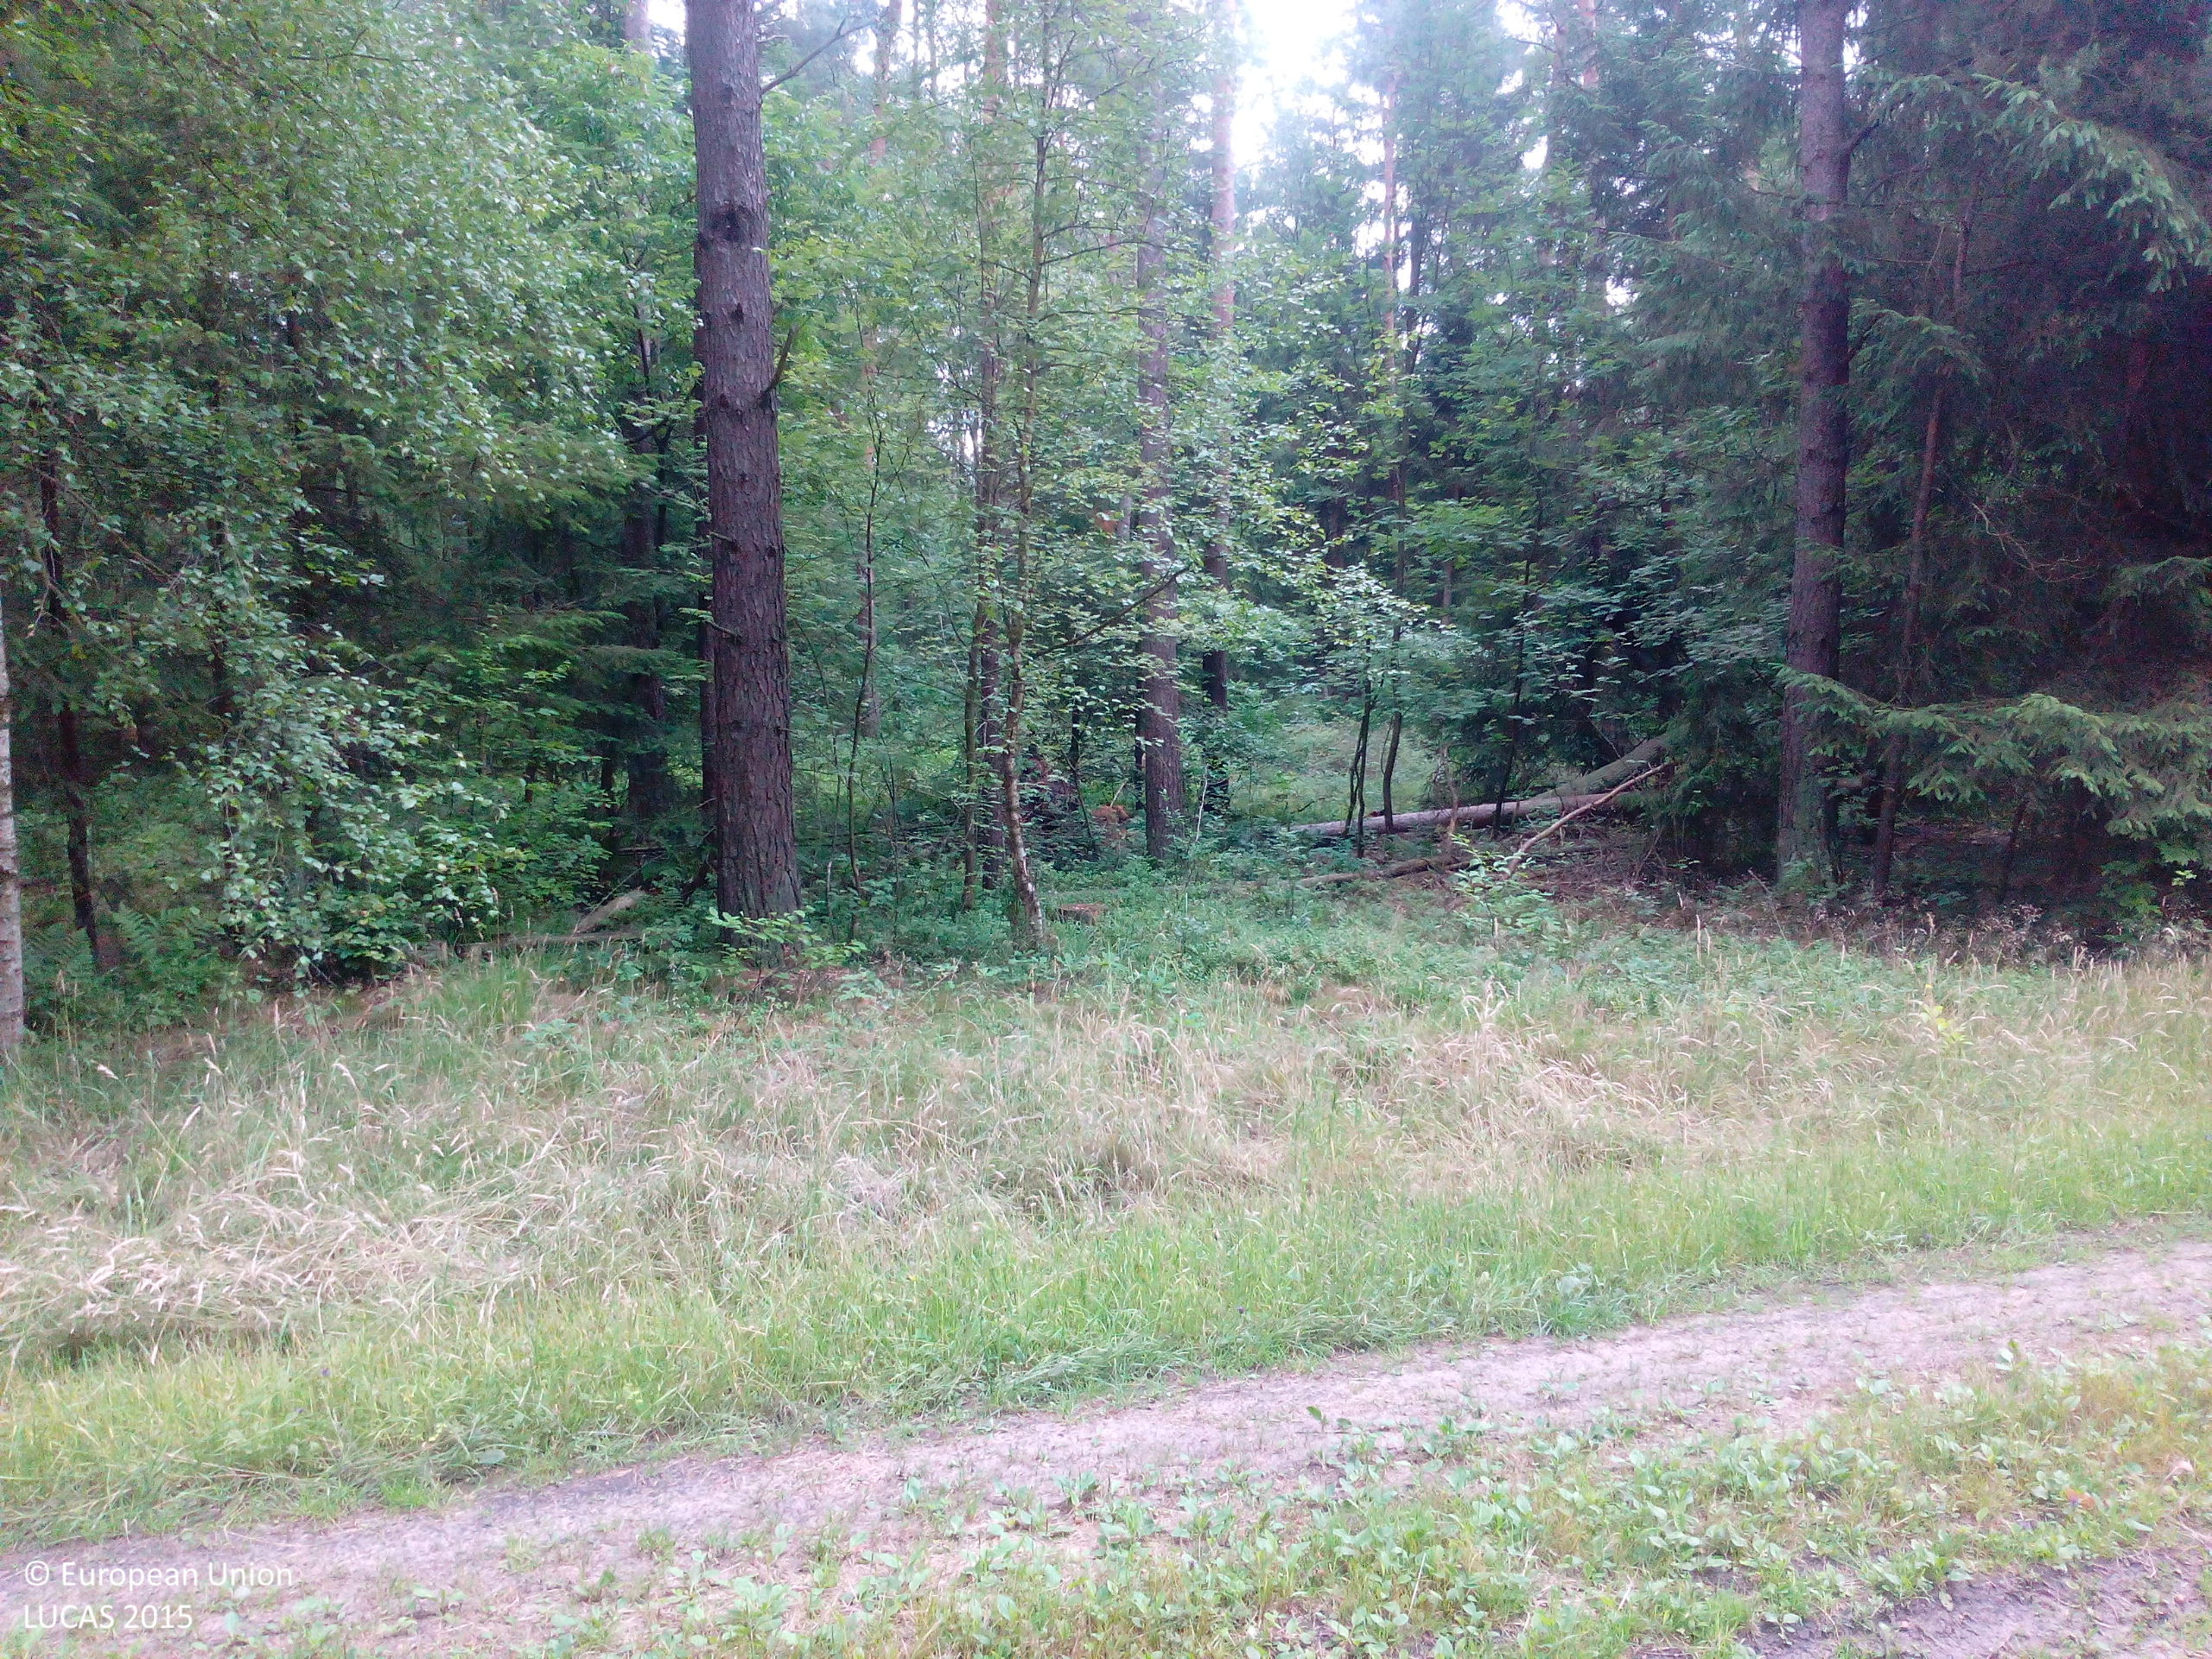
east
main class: Grassland
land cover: Grassland without tree/shrub cover
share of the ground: > 75 %
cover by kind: herbaceous plants 90 %, unconsolidated bare surface 10 %
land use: Road transport
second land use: Forestry
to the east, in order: Grassland without tree/shrub cover; Tracks; Pine dominated coniferous woodland; Tracks; Pine dominated coniferous woodland; Broadleaved woodland; Pine dominated coniferous woodland
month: July
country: DE
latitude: 52.8444
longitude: 10.3117
